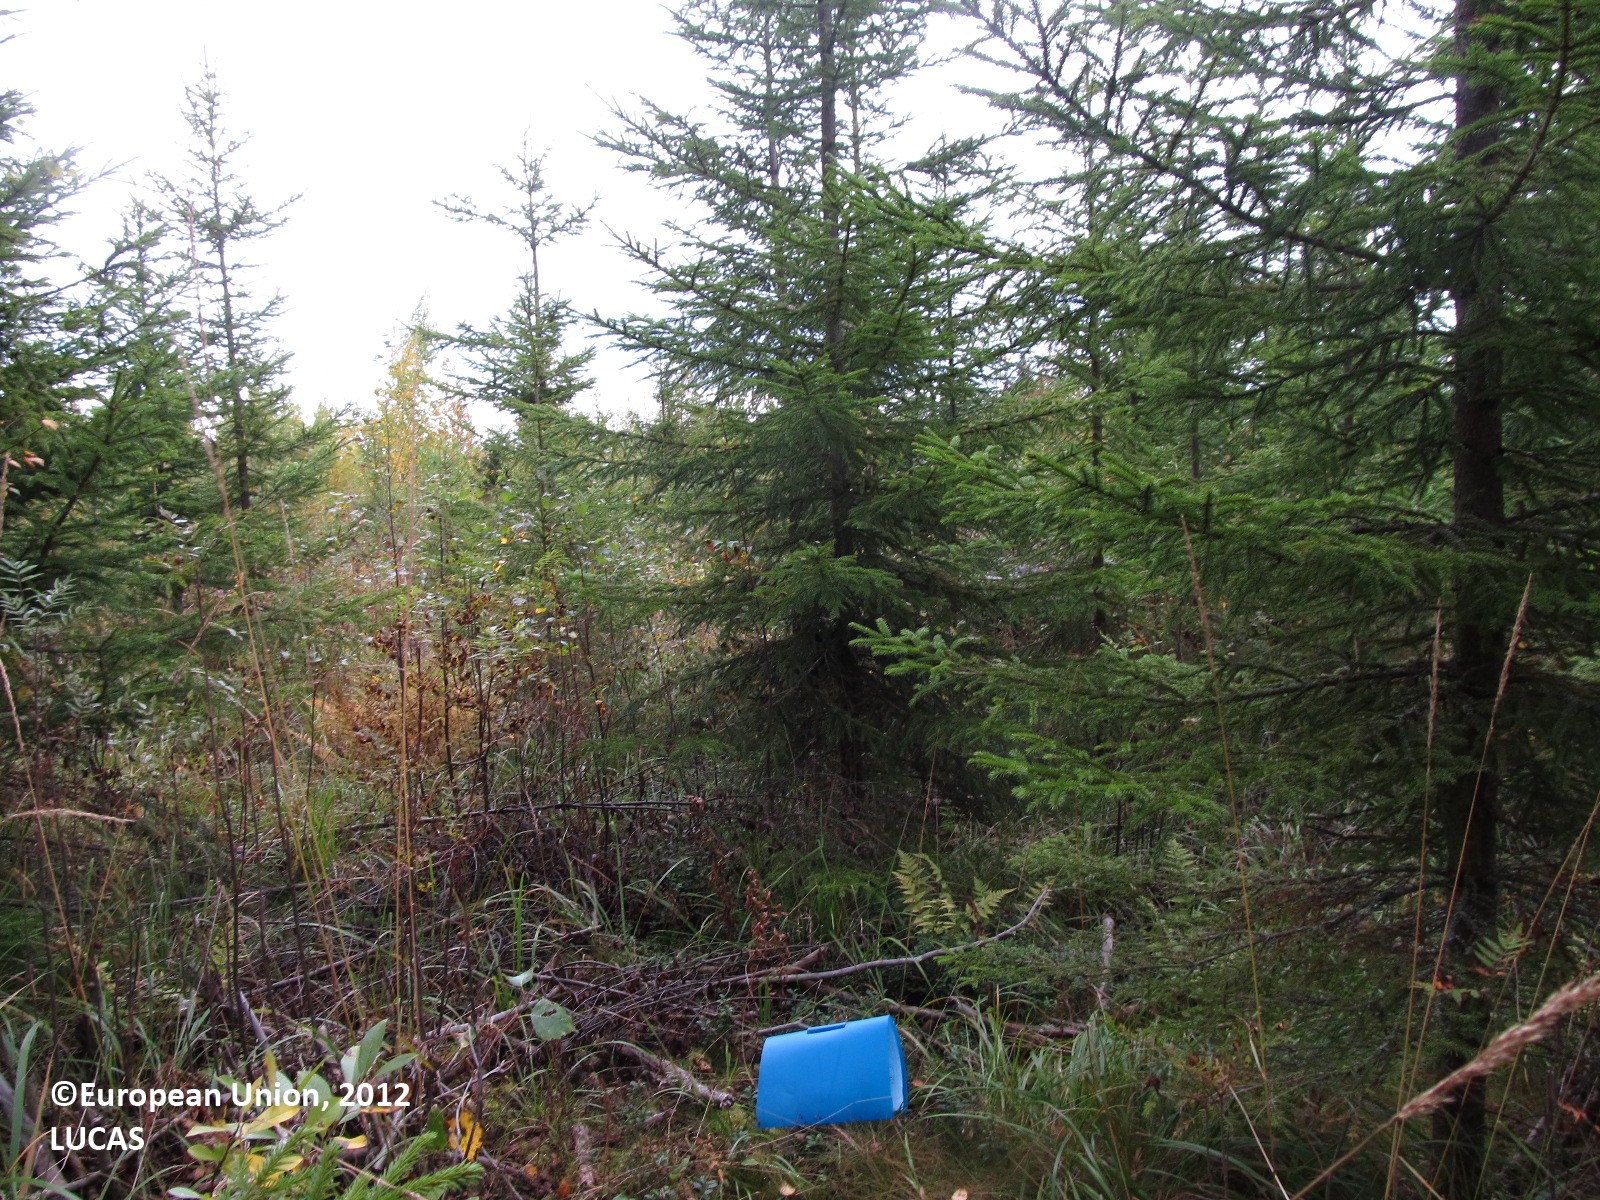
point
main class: Woodland
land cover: Spruce dominated coniferous woodland
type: boreal forest
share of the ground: 50 - 75 %
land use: Forestry
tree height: > 5 m
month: September
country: FI
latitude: 62.6787
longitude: 28.4982
